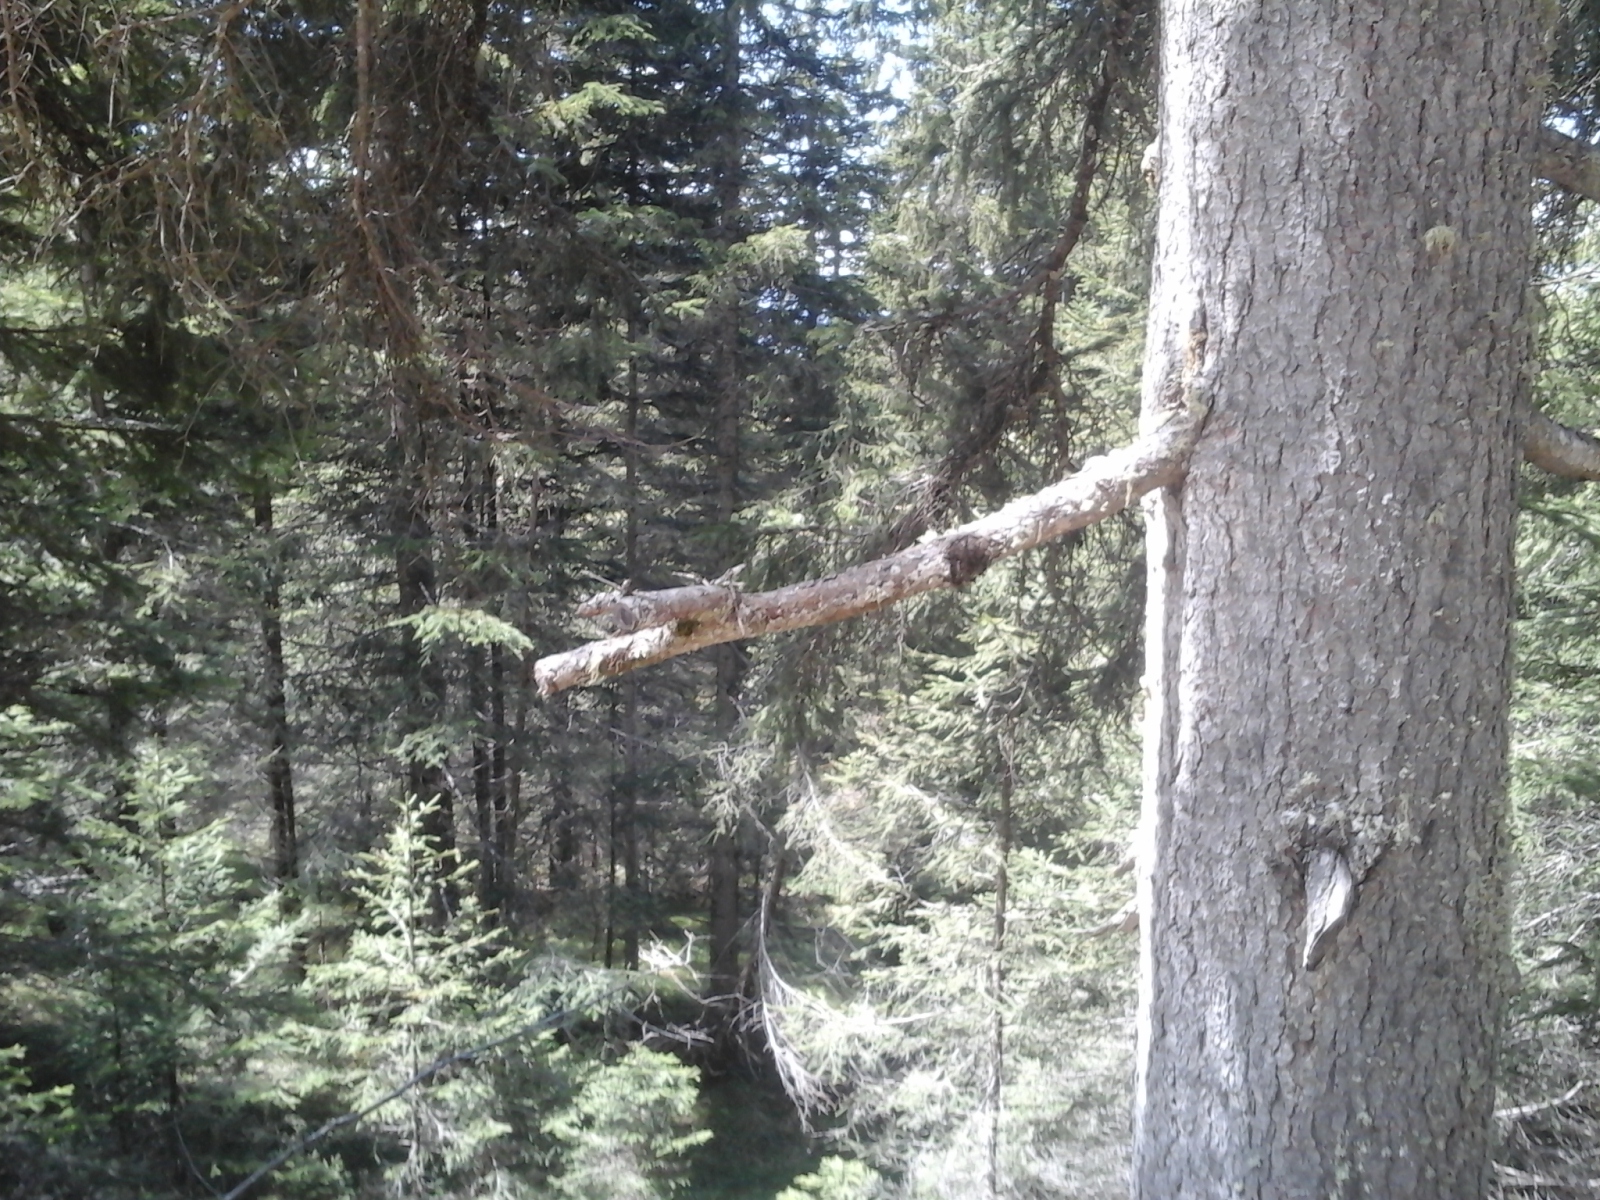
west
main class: Woodland
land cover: Spruce dominated coniferous woodland
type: alpine coniferous forest
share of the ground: > 75 %
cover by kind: coniferous forest trees 100 %
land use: Forestry
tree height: > 5 m
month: May
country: IT
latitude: 46.3419
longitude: 11.4144
